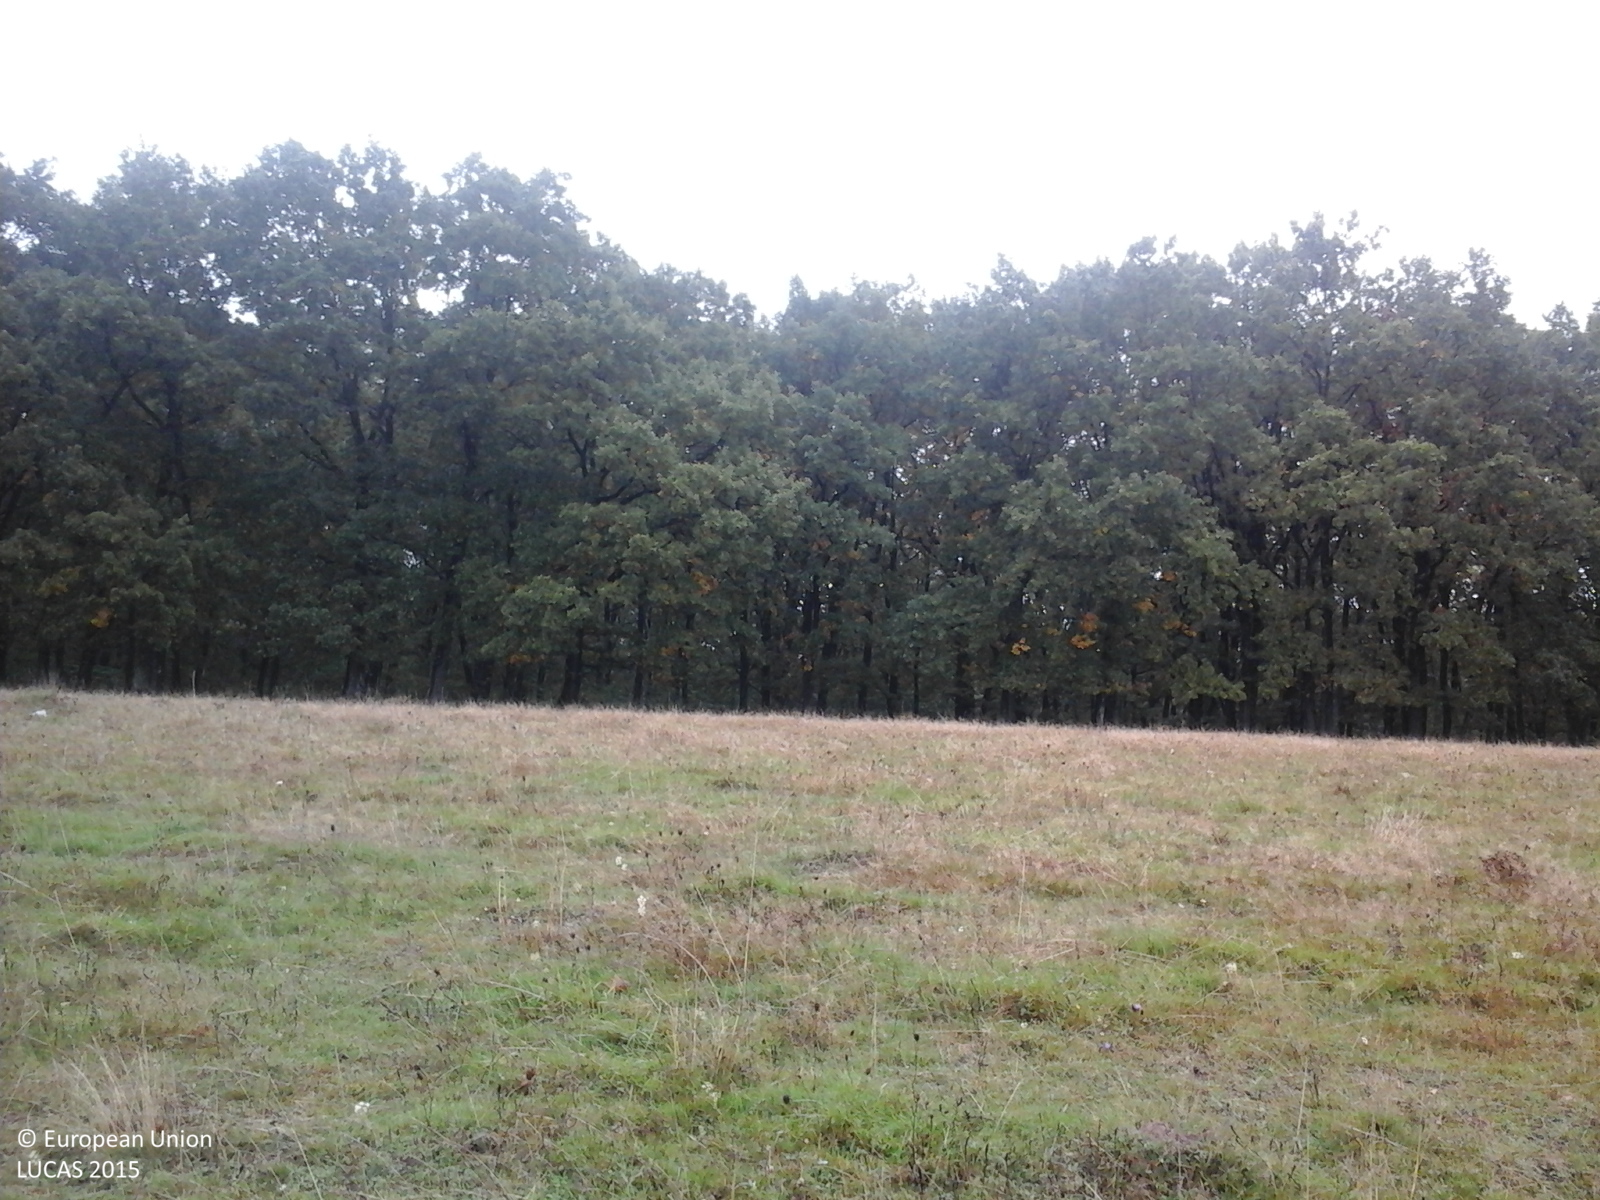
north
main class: Grassland
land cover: Grassland without tree/shrub cover
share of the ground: > 75 %
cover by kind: herbaceous plants 100 %
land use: Agriculture (excluding fallow land and kitchen gardens)
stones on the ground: < 10 %
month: October
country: RO
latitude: 45.8075
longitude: 24.0082
